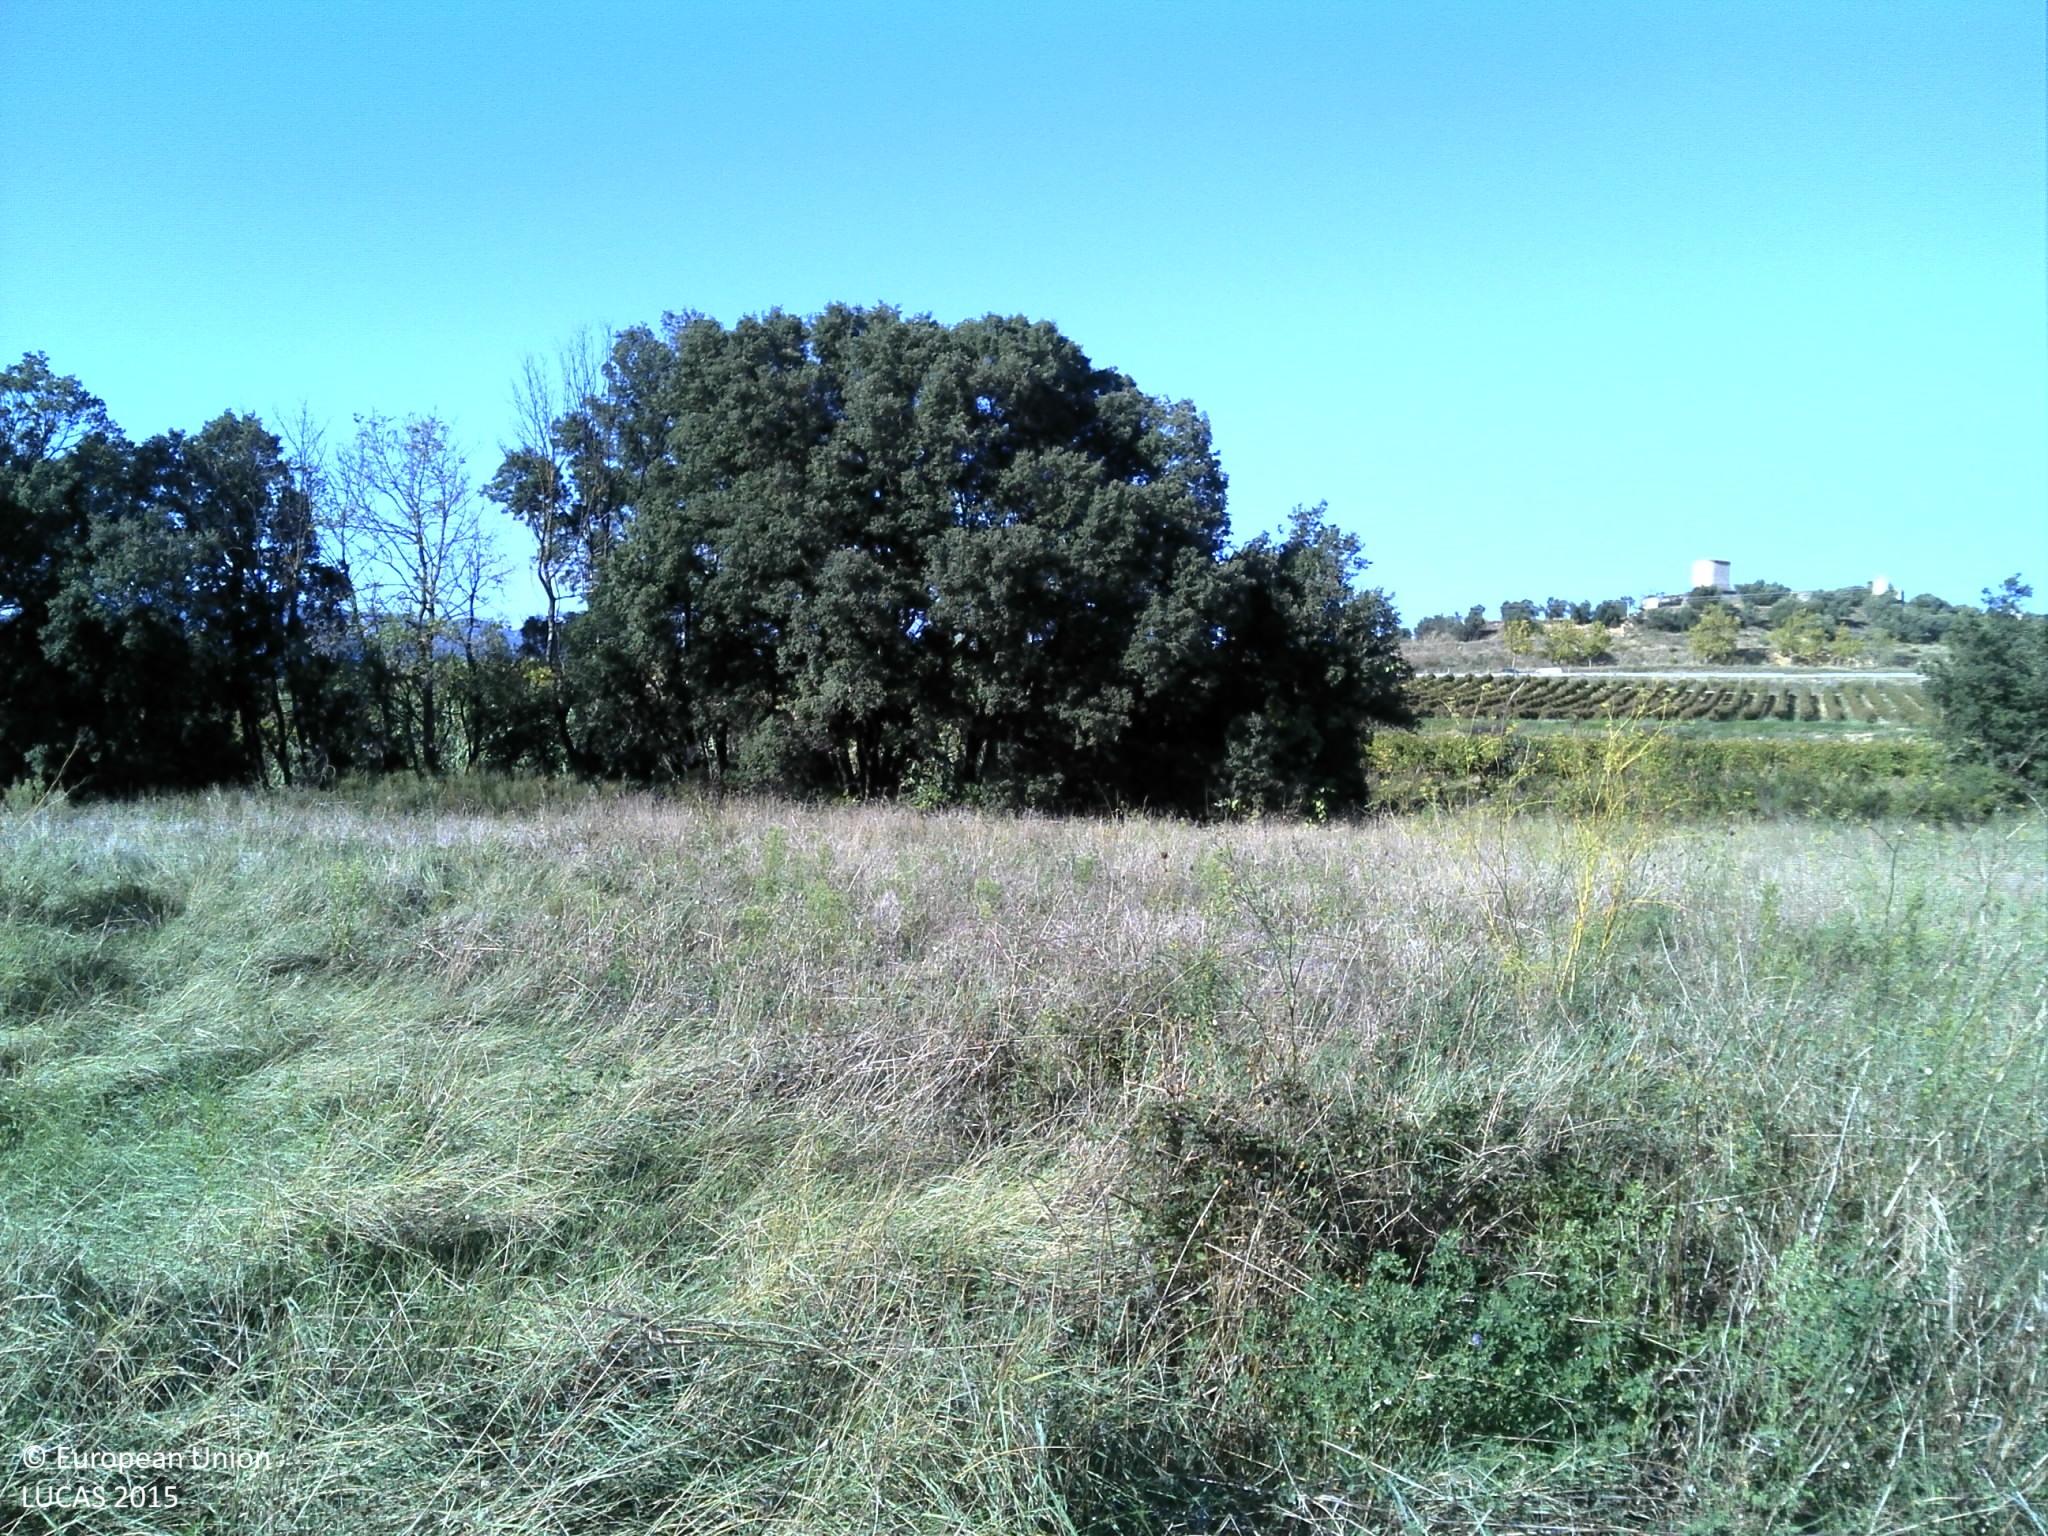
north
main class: Grassland
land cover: Grassland without tree/shrub cover
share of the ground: > 75 %
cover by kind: herbaceous plants 100 %
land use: Agriculture (excluding fallow land and kitchen gardens)
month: October
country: FR
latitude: 43.6432
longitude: 3.5499
